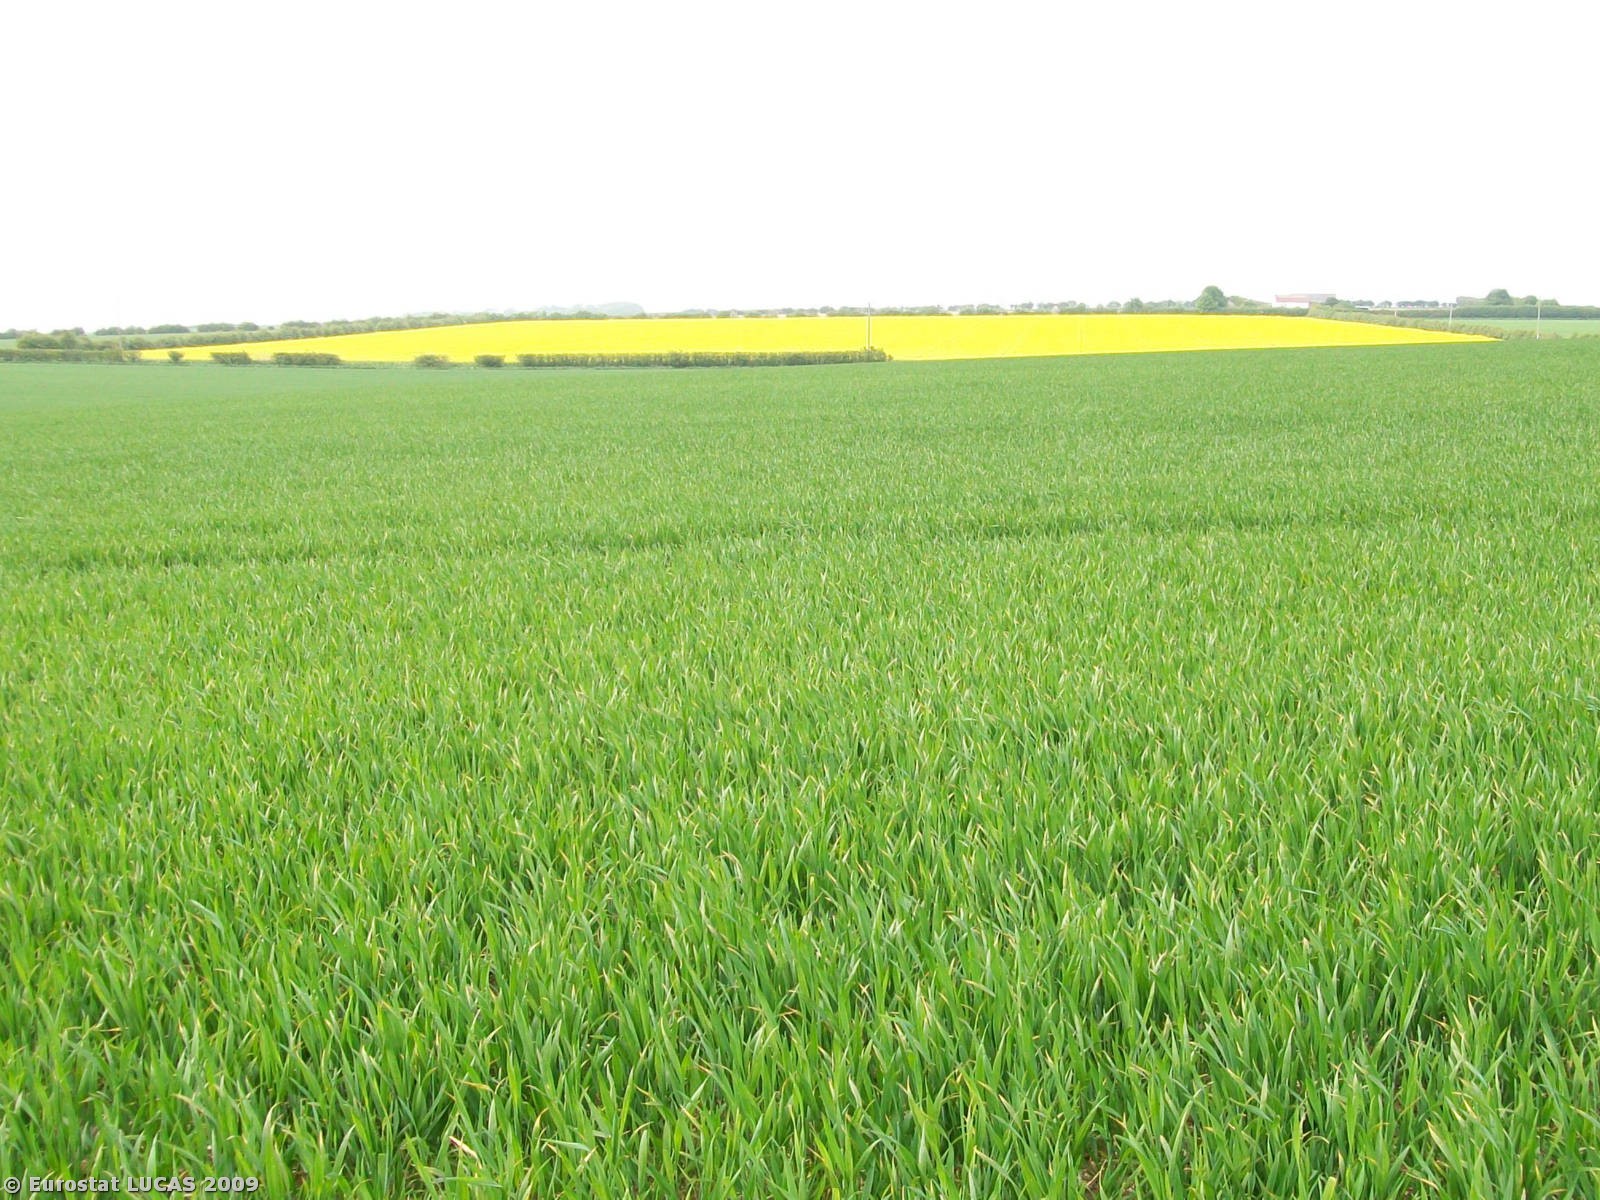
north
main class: Cropland
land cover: Common wheat
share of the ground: > 75 %
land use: Agriculture (excluding fallow land and kitchen gardens)
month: May
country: GB
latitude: 54.1371
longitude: -0.3354
